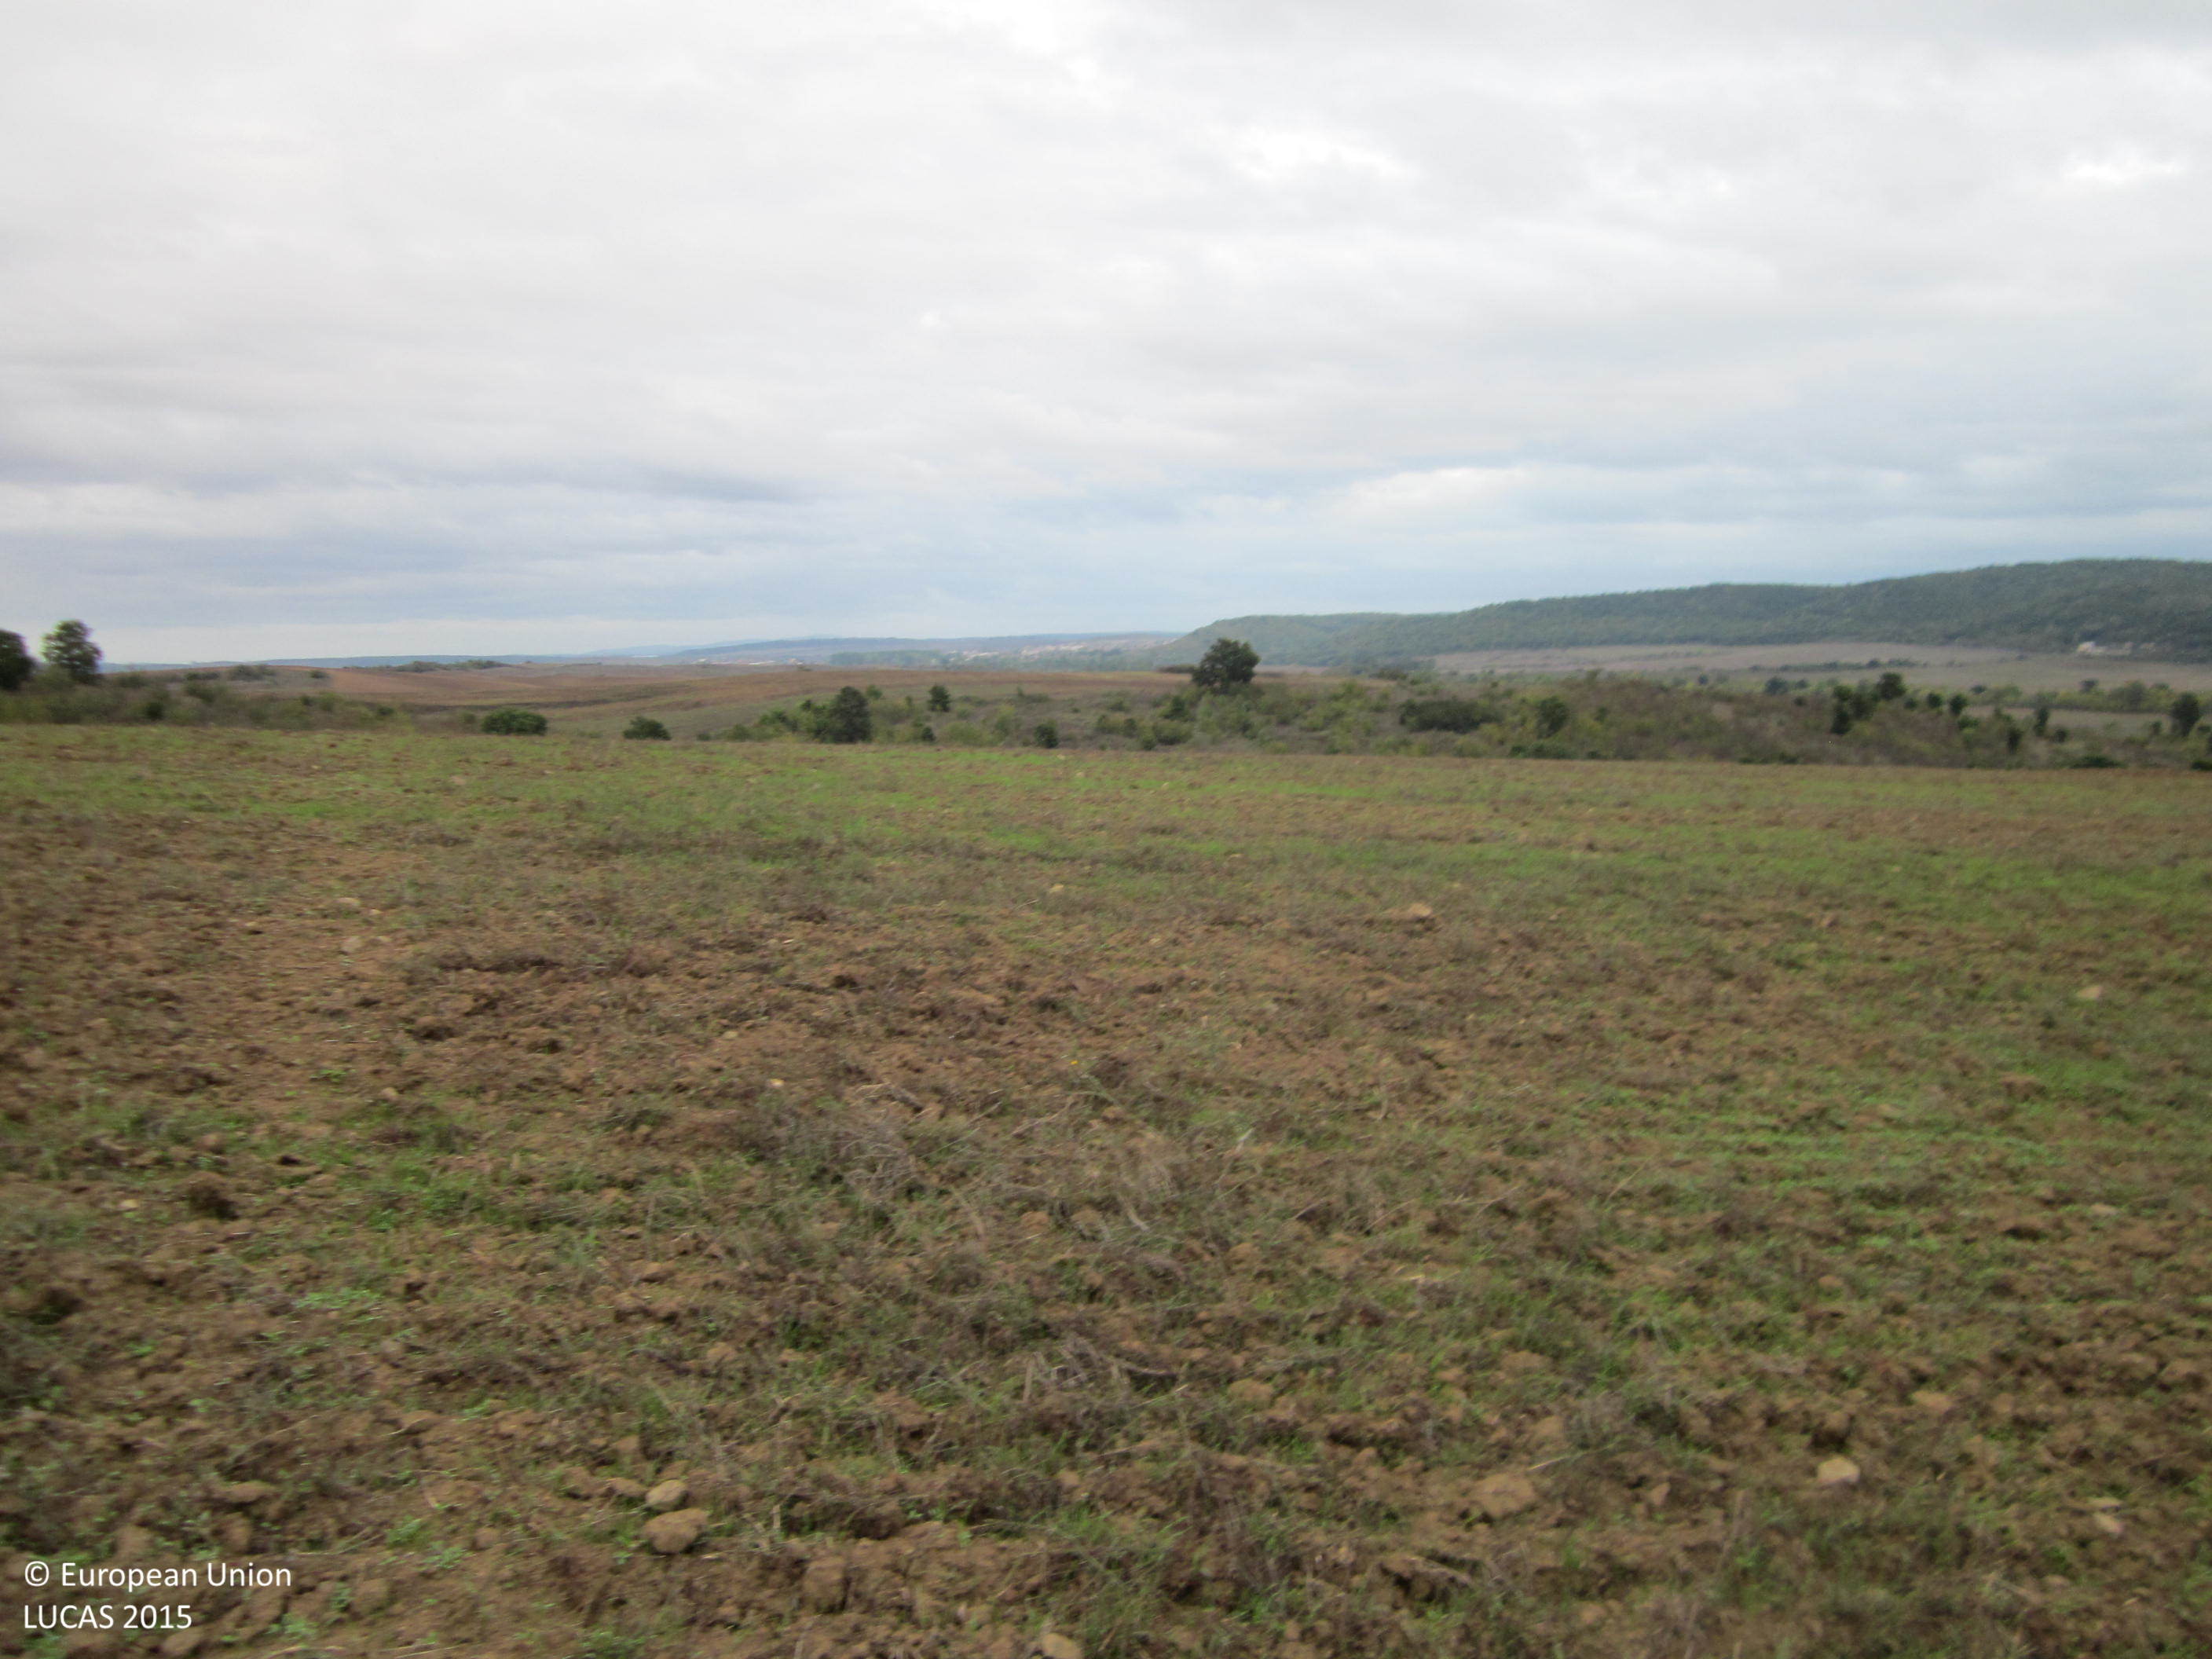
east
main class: Cropland
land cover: Common wheat
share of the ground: 10 - 25 %
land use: Agriculture (excluding fallow land and kitchen gardens)
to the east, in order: Common wheat; Shrubland with sparse tree cover
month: October
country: BG
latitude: 42.3454
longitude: 27.1117
